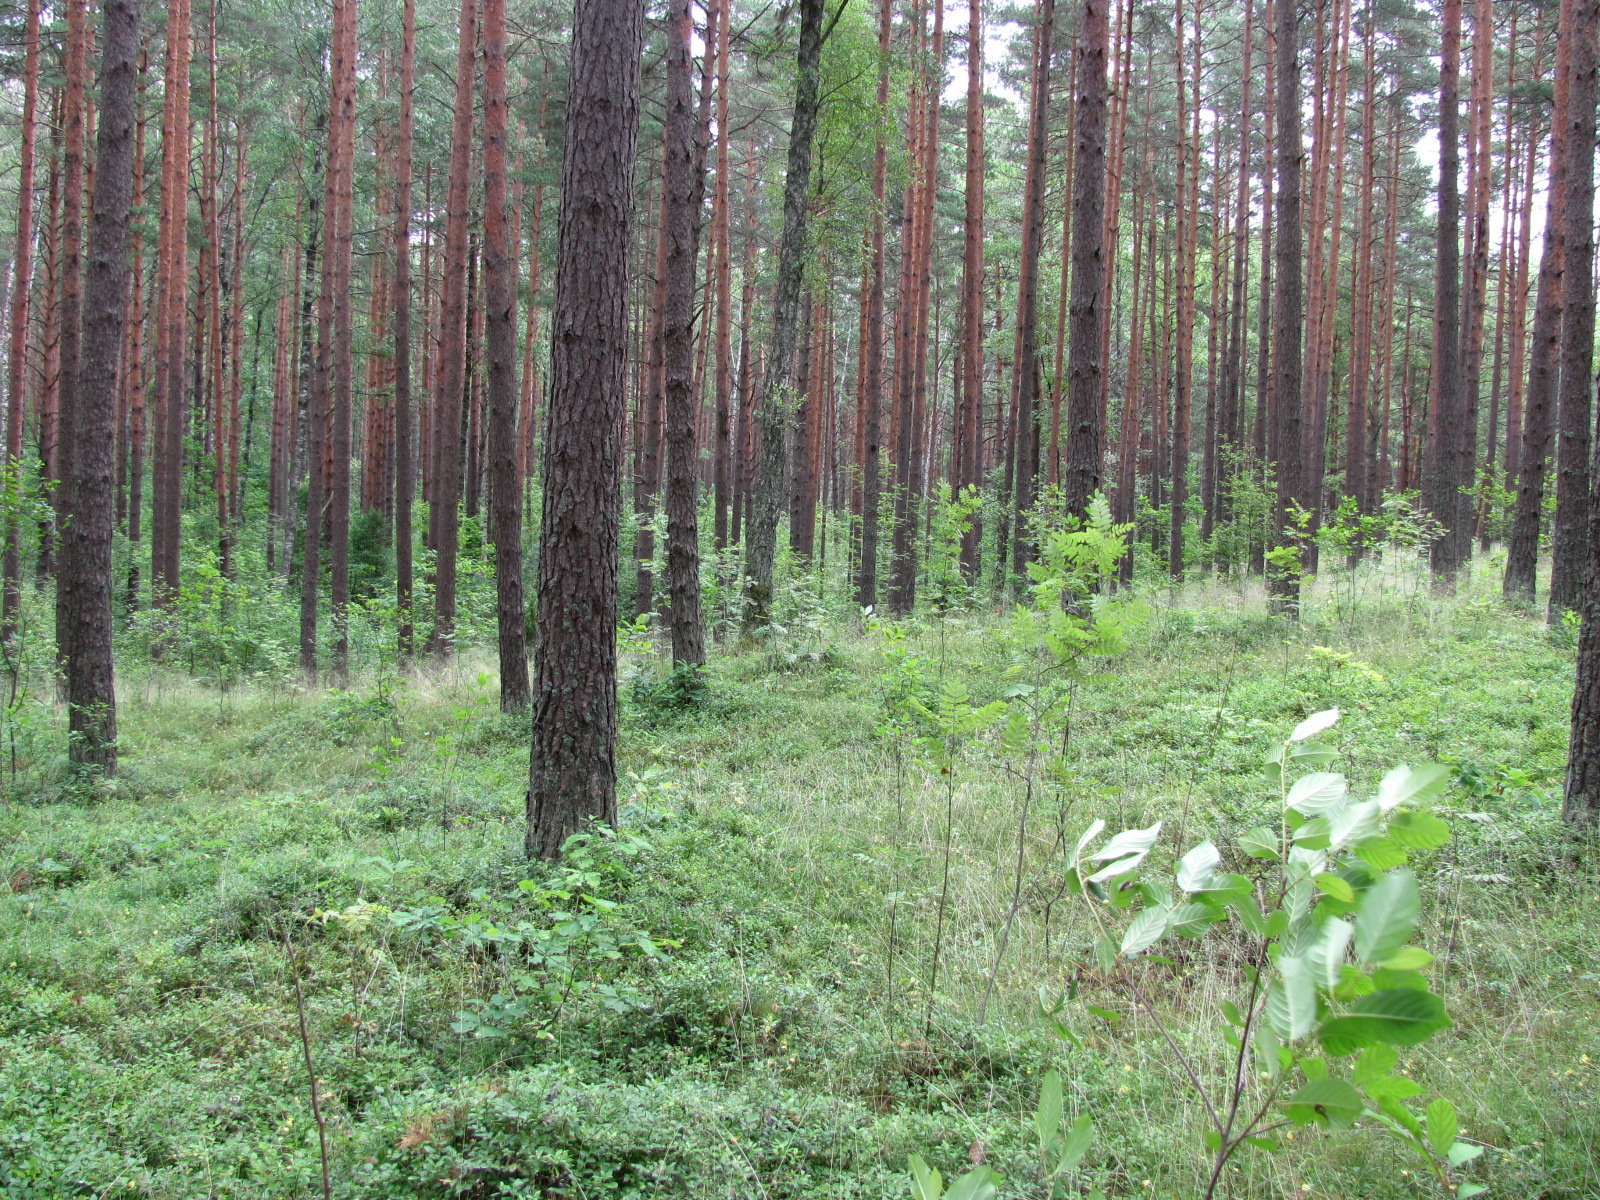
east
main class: Woodland
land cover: Pine dominated coniferous woodland
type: hemiboreal forest and nemoral coniferous forest and mixed broadleaved-coniferous forest
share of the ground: > 75 %
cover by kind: coniferous forest trees 80 %, shrubs 10 %, herbaceous plants 10 %
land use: Forestry
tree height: > 5 m
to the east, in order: Pine dominated coniferous woodland; Pine dominated mixed woodland
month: July
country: LV
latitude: 57.0626
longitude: 24.1520
